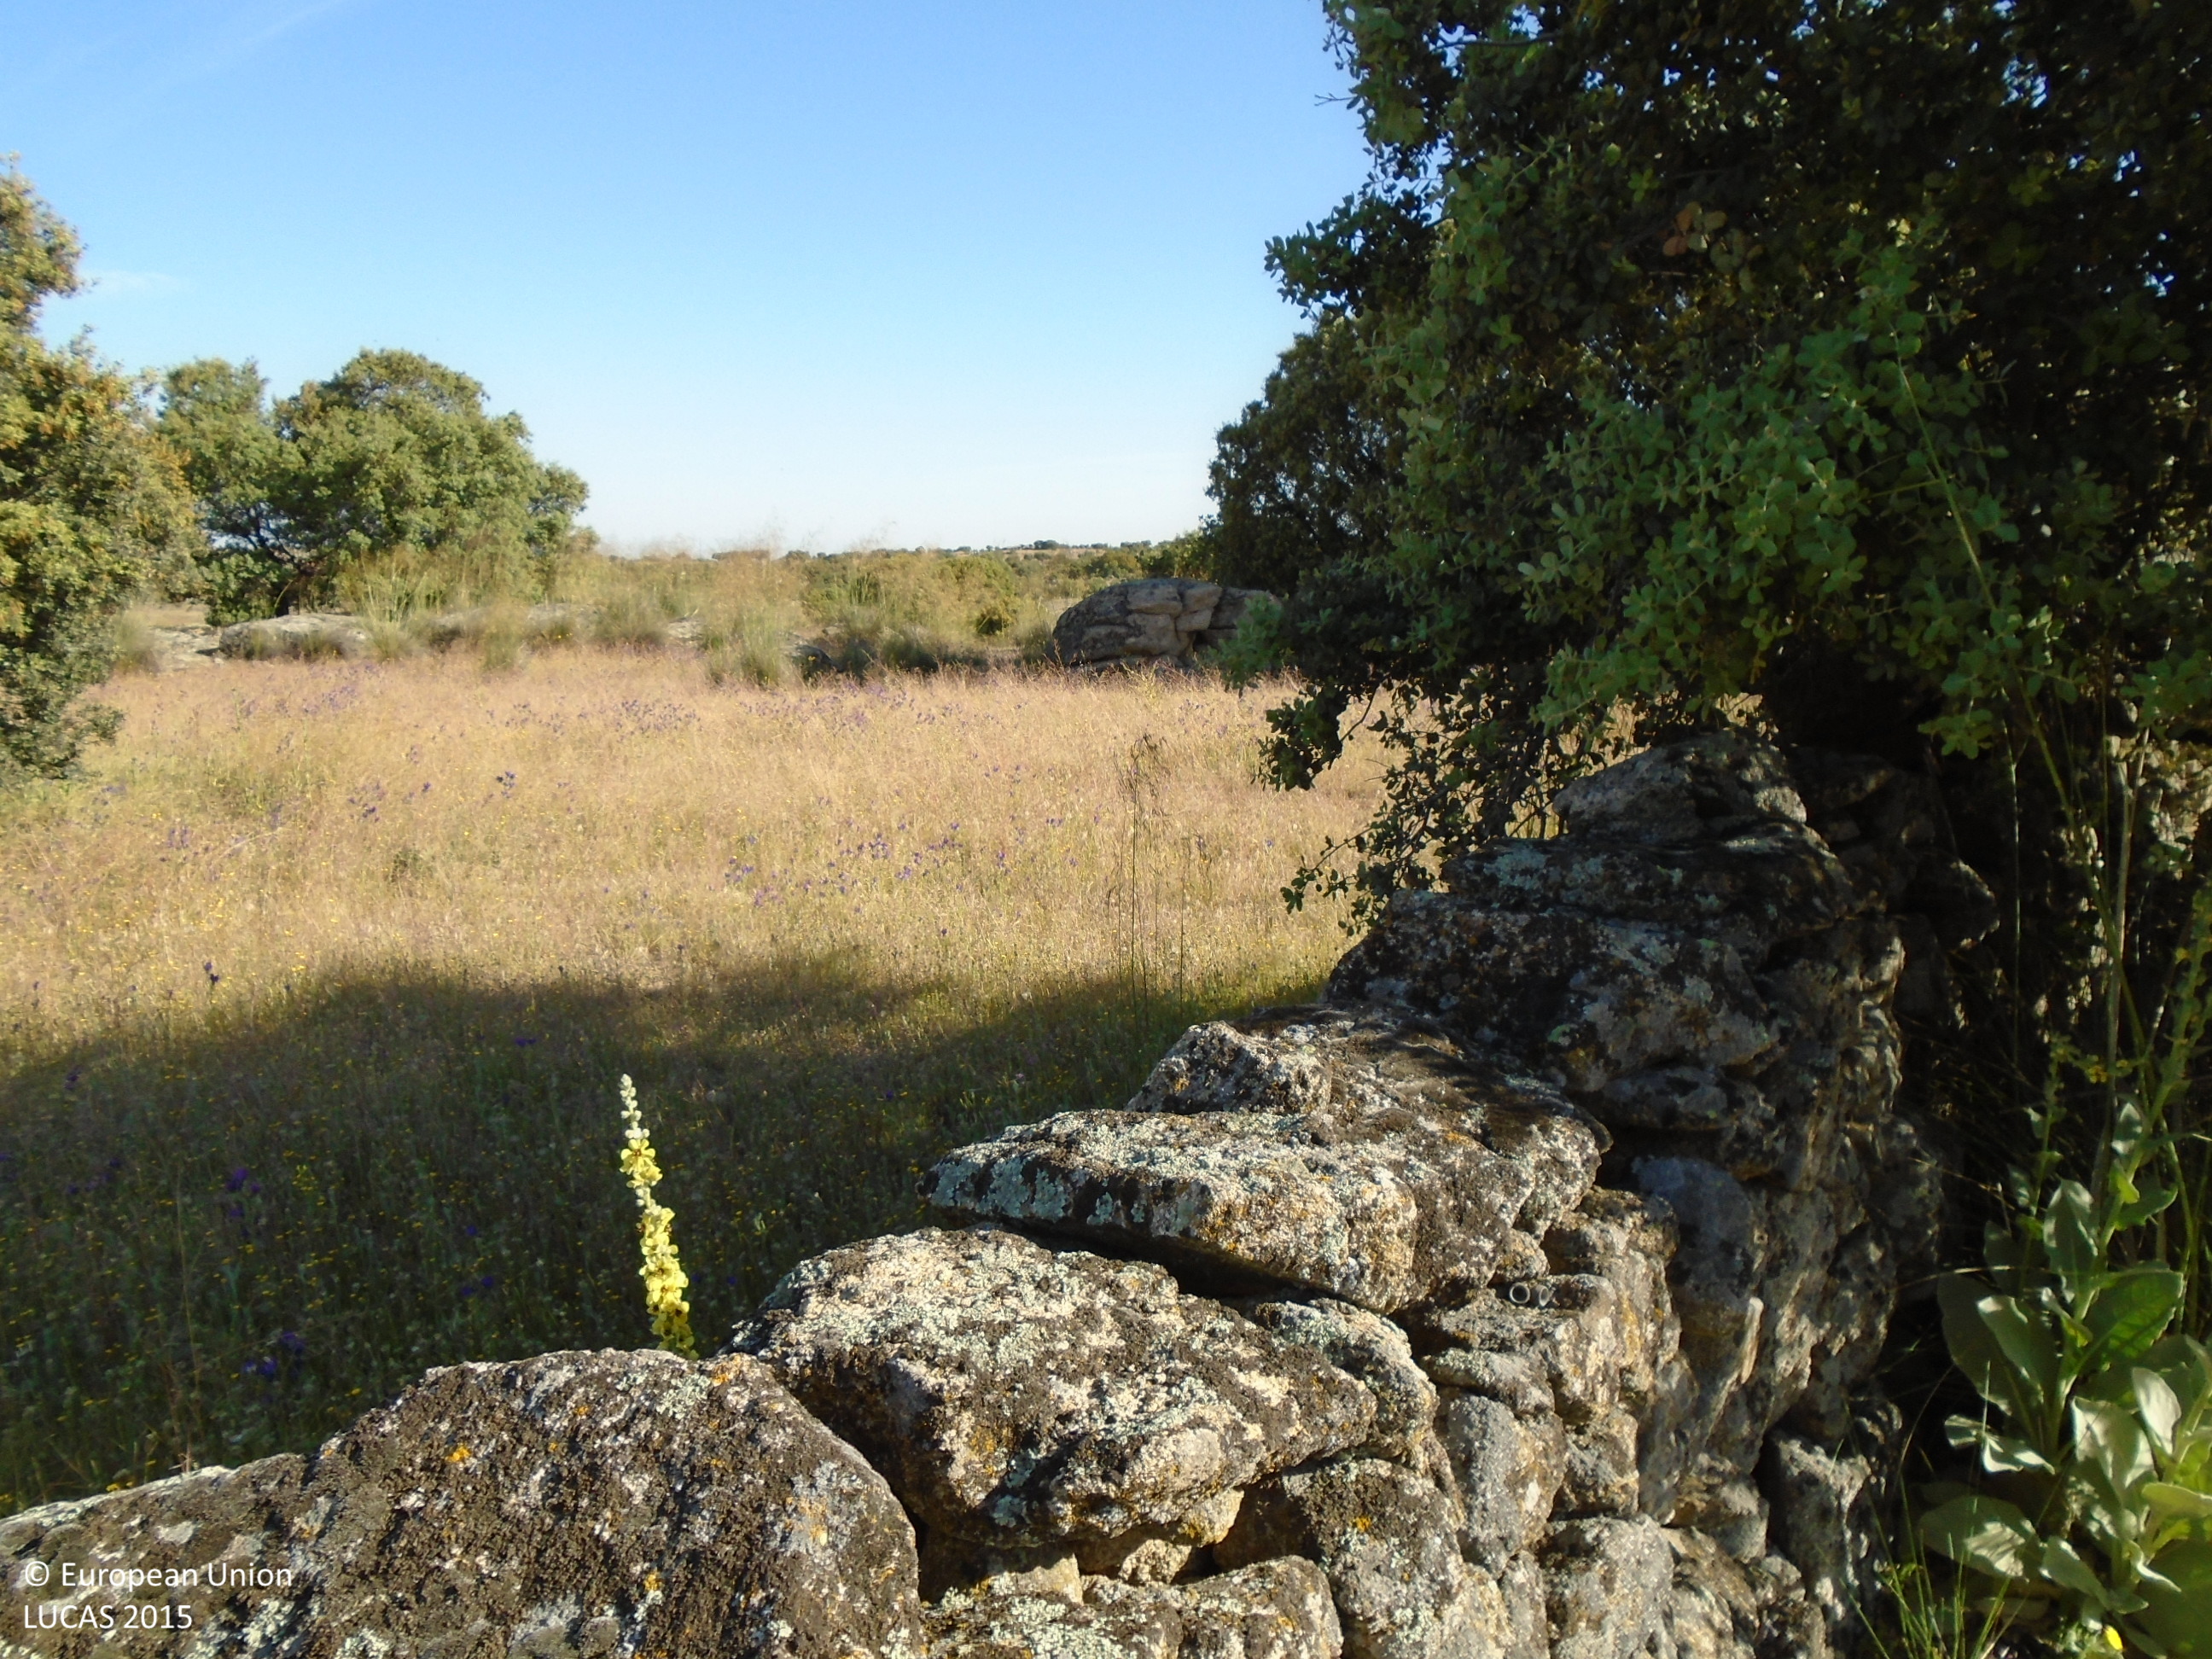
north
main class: Grassland
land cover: Grassland without tree/shrub cover
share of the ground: > 75 %
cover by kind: herbaceous plants 95 %, consolidated bare surface 5 %
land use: Agriculture (excluding fallow land and kitchen gardens)
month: May
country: ES
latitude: 39.5914
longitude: -4.2276
